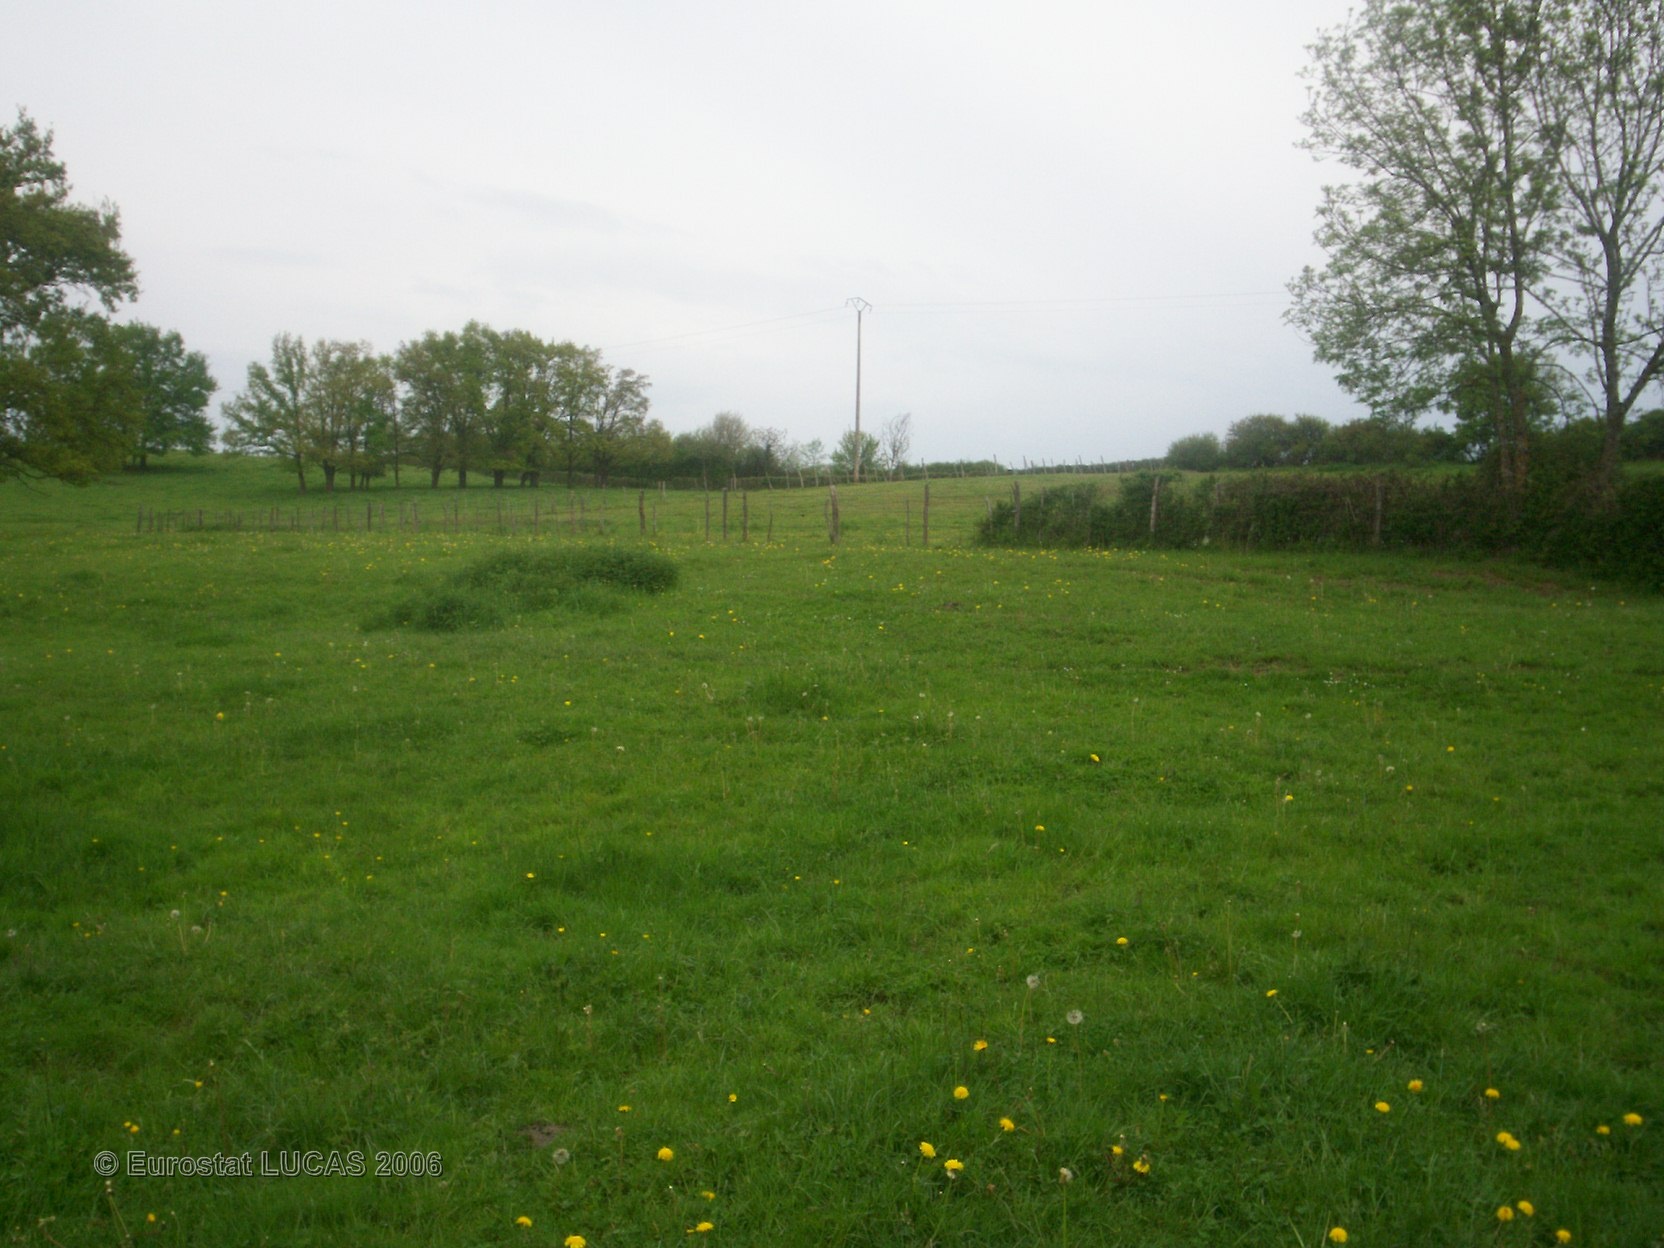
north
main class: Grassland
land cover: Grassland with sparse tree/shrub cover
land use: Agriculture (excluding fallow land and kitchen gardens)
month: May
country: FR
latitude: 46.0370
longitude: 3.0861
